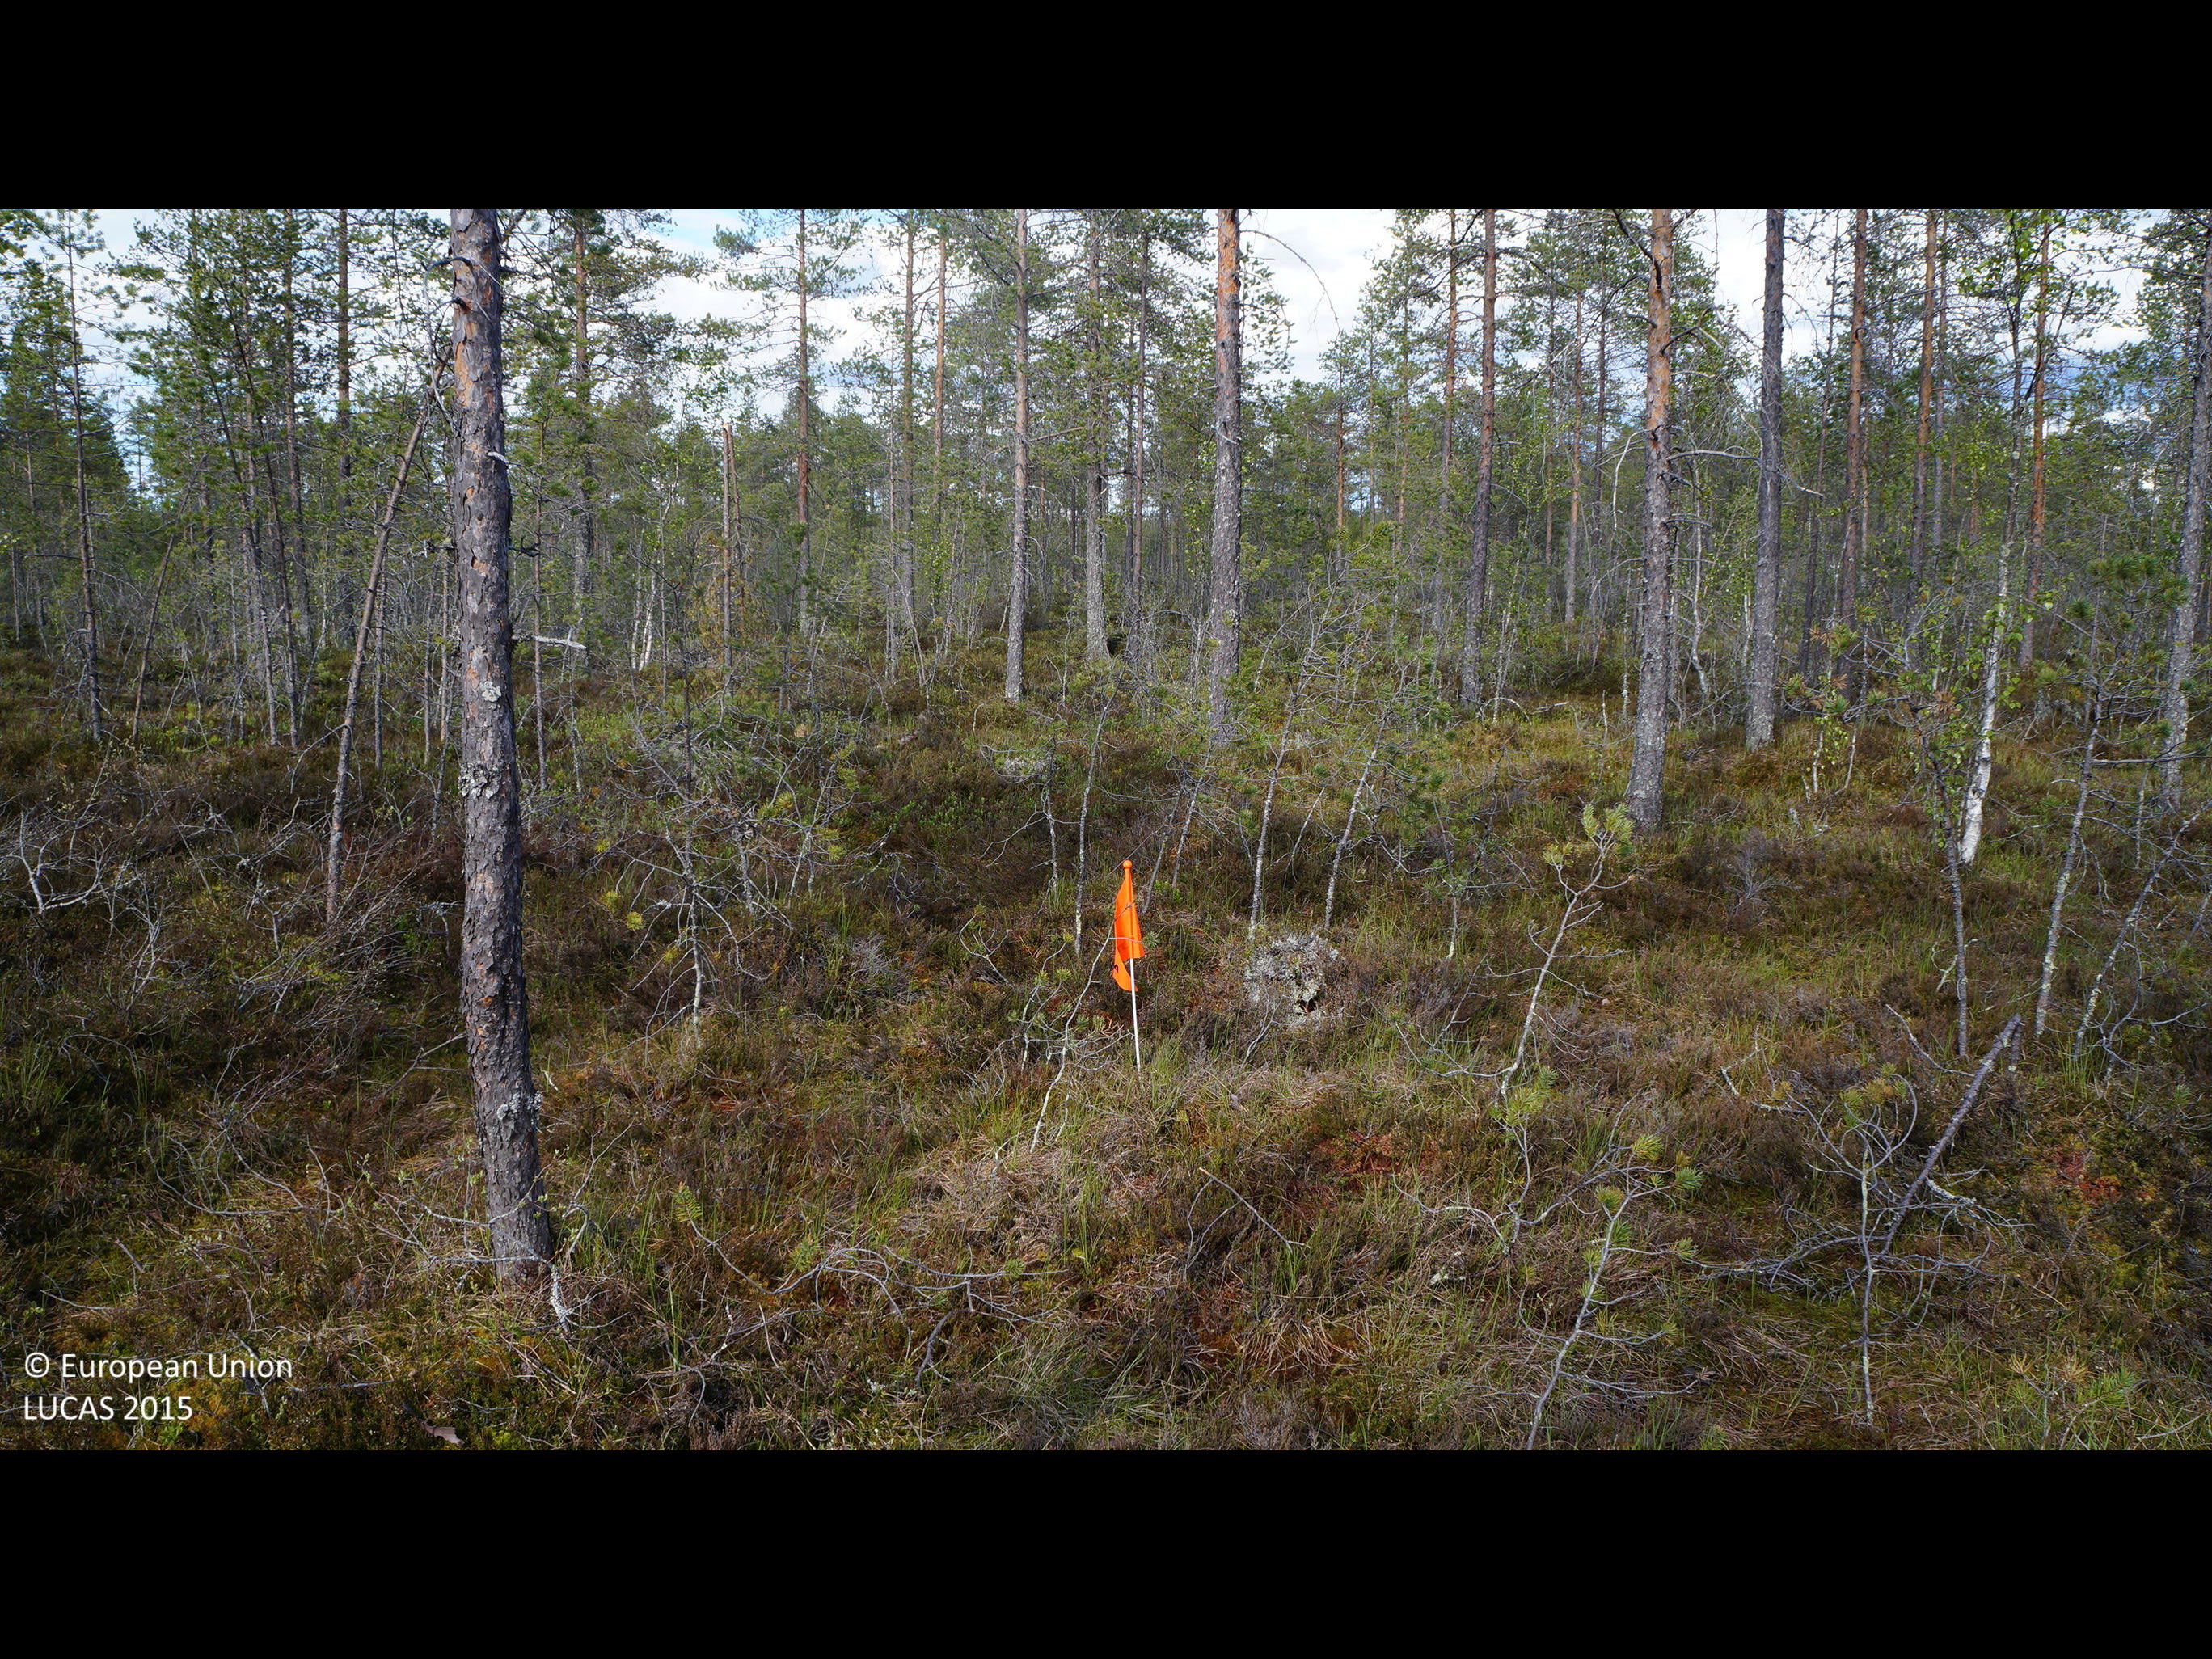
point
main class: Woodland
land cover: Pine dominated coniferous woodland
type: boreal forest
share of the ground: 50 - 75 %
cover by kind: coniferous forest trees 70 %, lichens and mosses 20 %, herbaceous plants 10 %
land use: Forestry
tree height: > 5 m
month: June
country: FI
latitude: 63.8015
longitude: 24.0979
